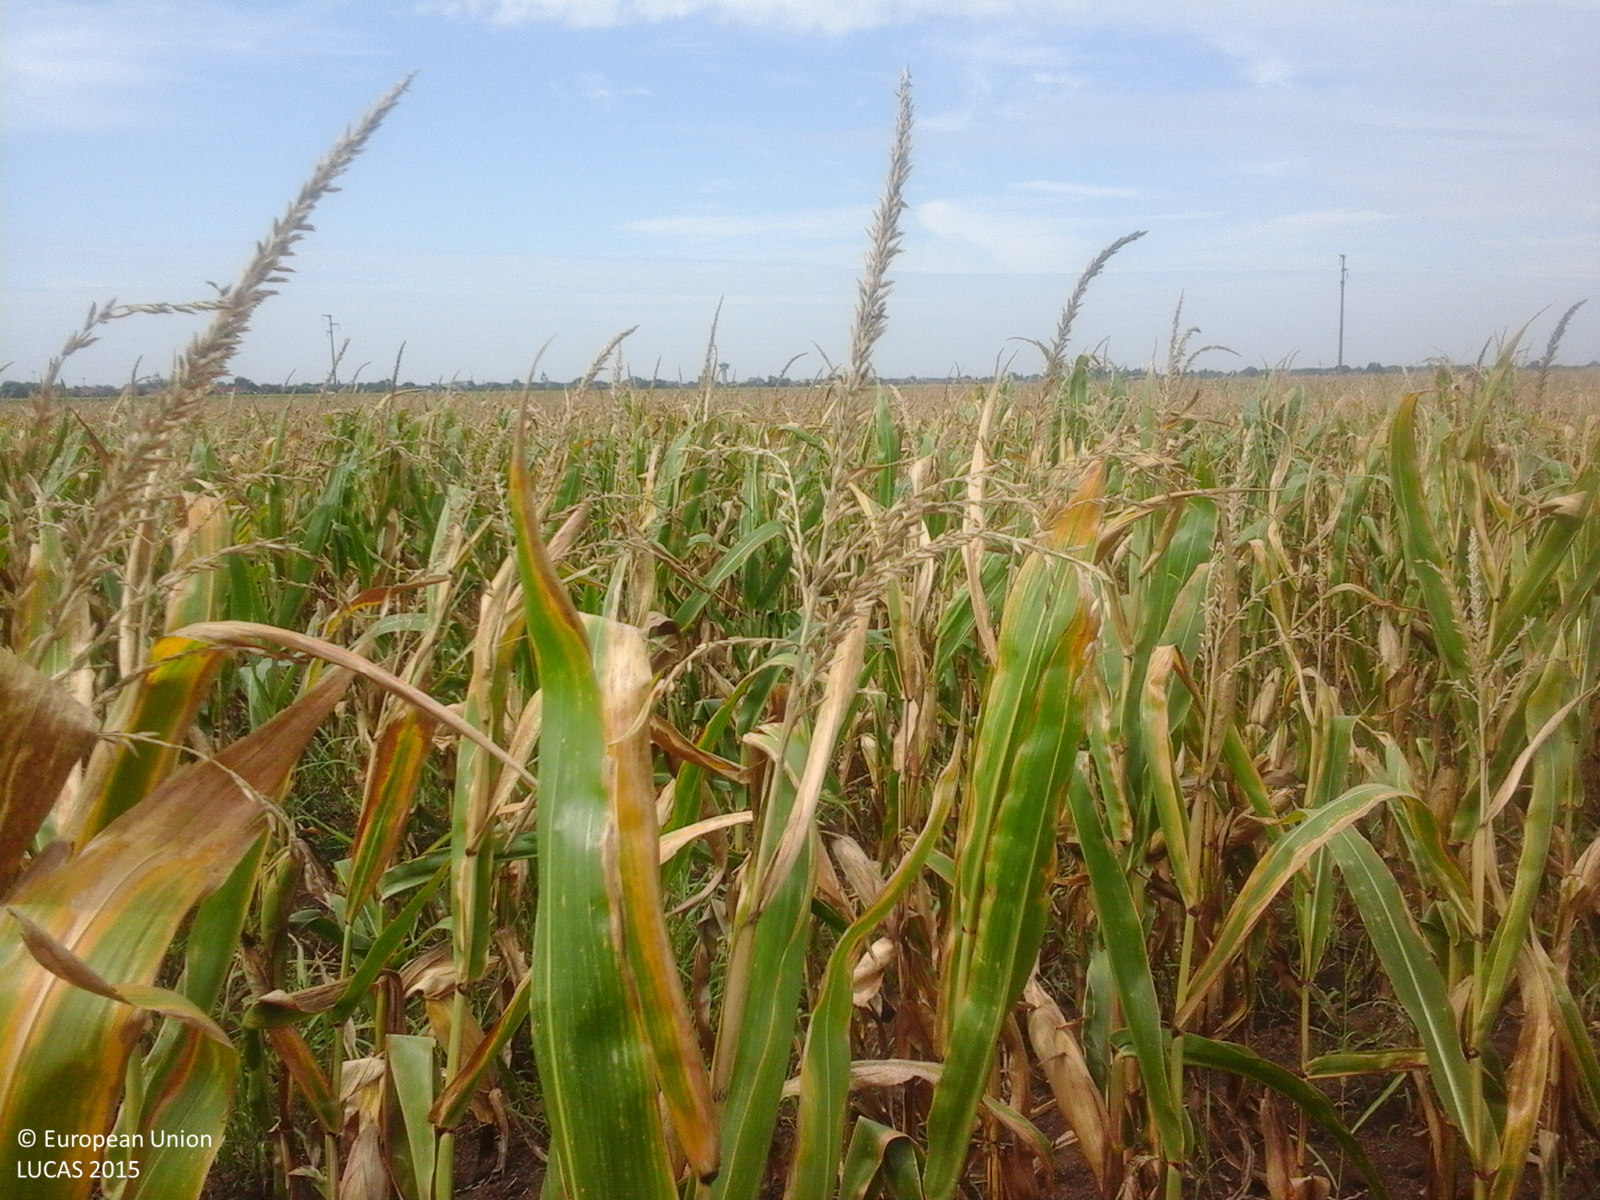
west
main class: Cropland
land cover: Maize
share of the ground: > 75 %
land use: Agriculture (excluding fallow land and kitchen gardens)
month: August
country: RO
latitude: 46.3431
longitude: 21.5362
